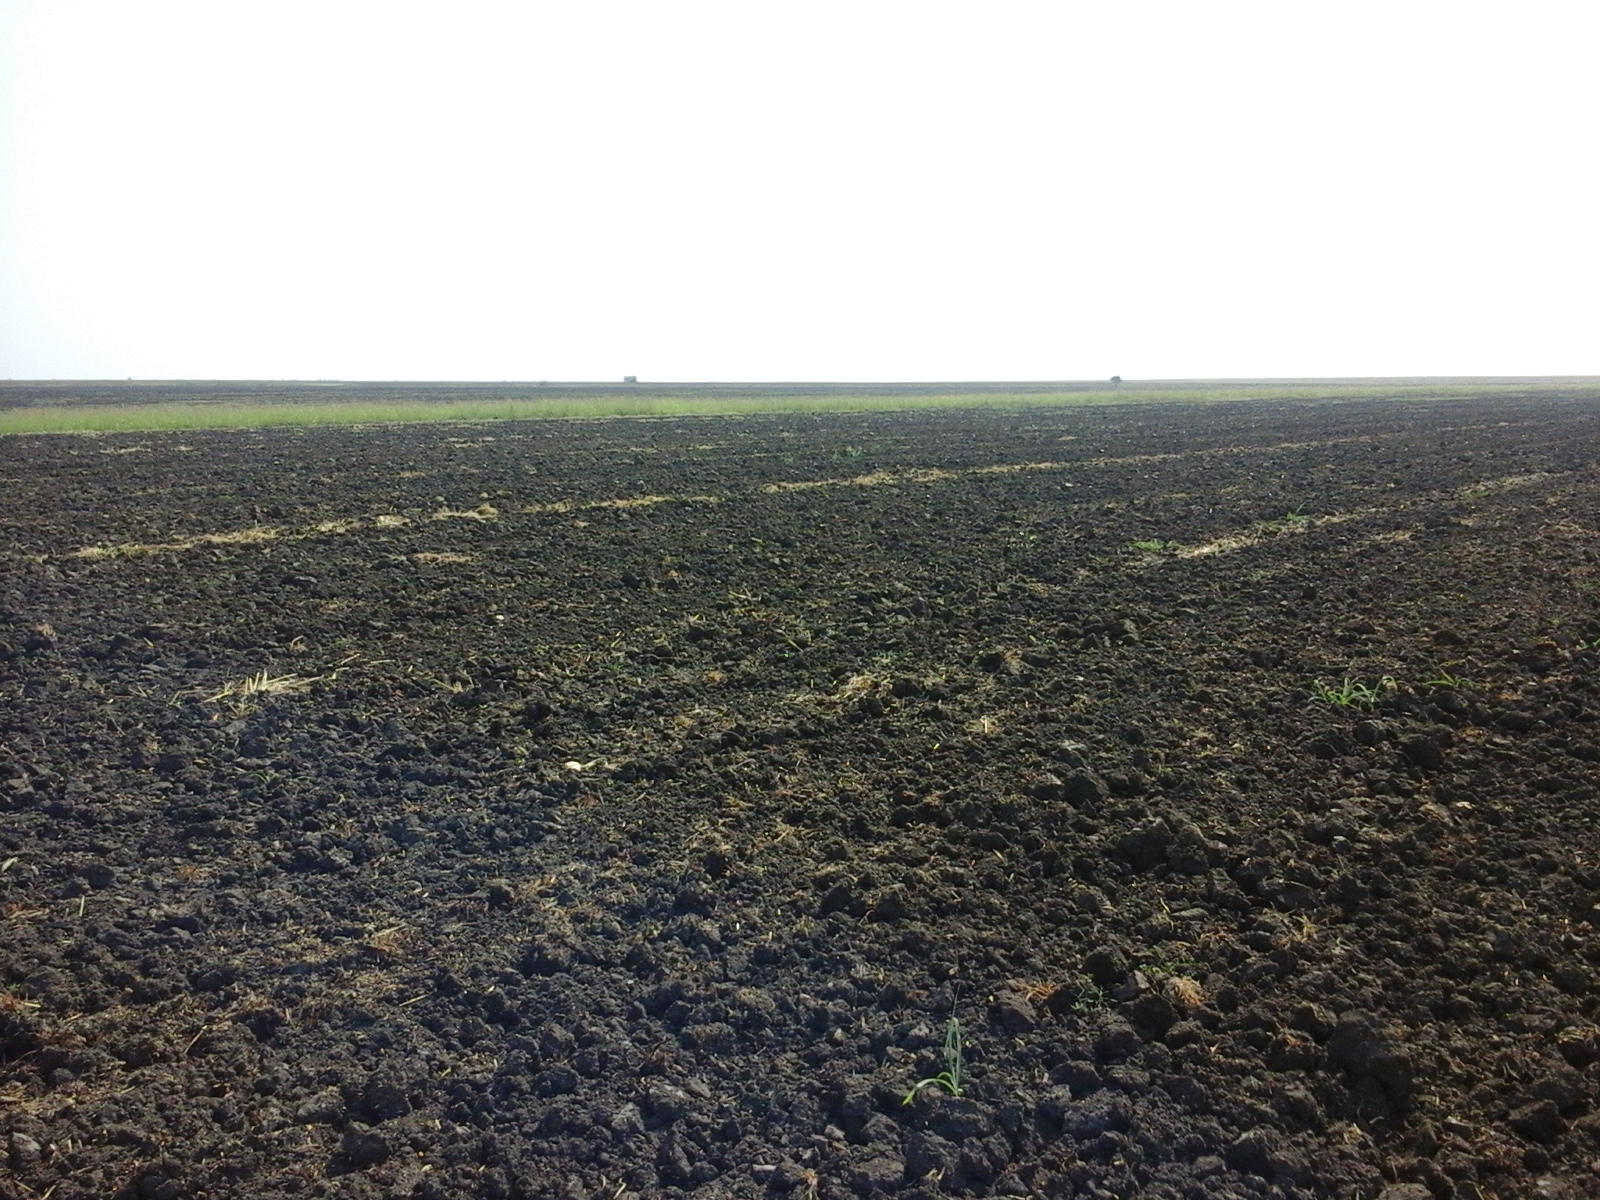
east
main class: Cropland
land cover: Common wheat
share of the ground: < 10 %
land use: Agriculture (excluding fallow land and kitchen gardens)
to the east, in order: Common wheat; Grassland without tree/shrub cover; Common wheat
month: August
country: RO
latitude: 44.0494
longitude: 23.4917
